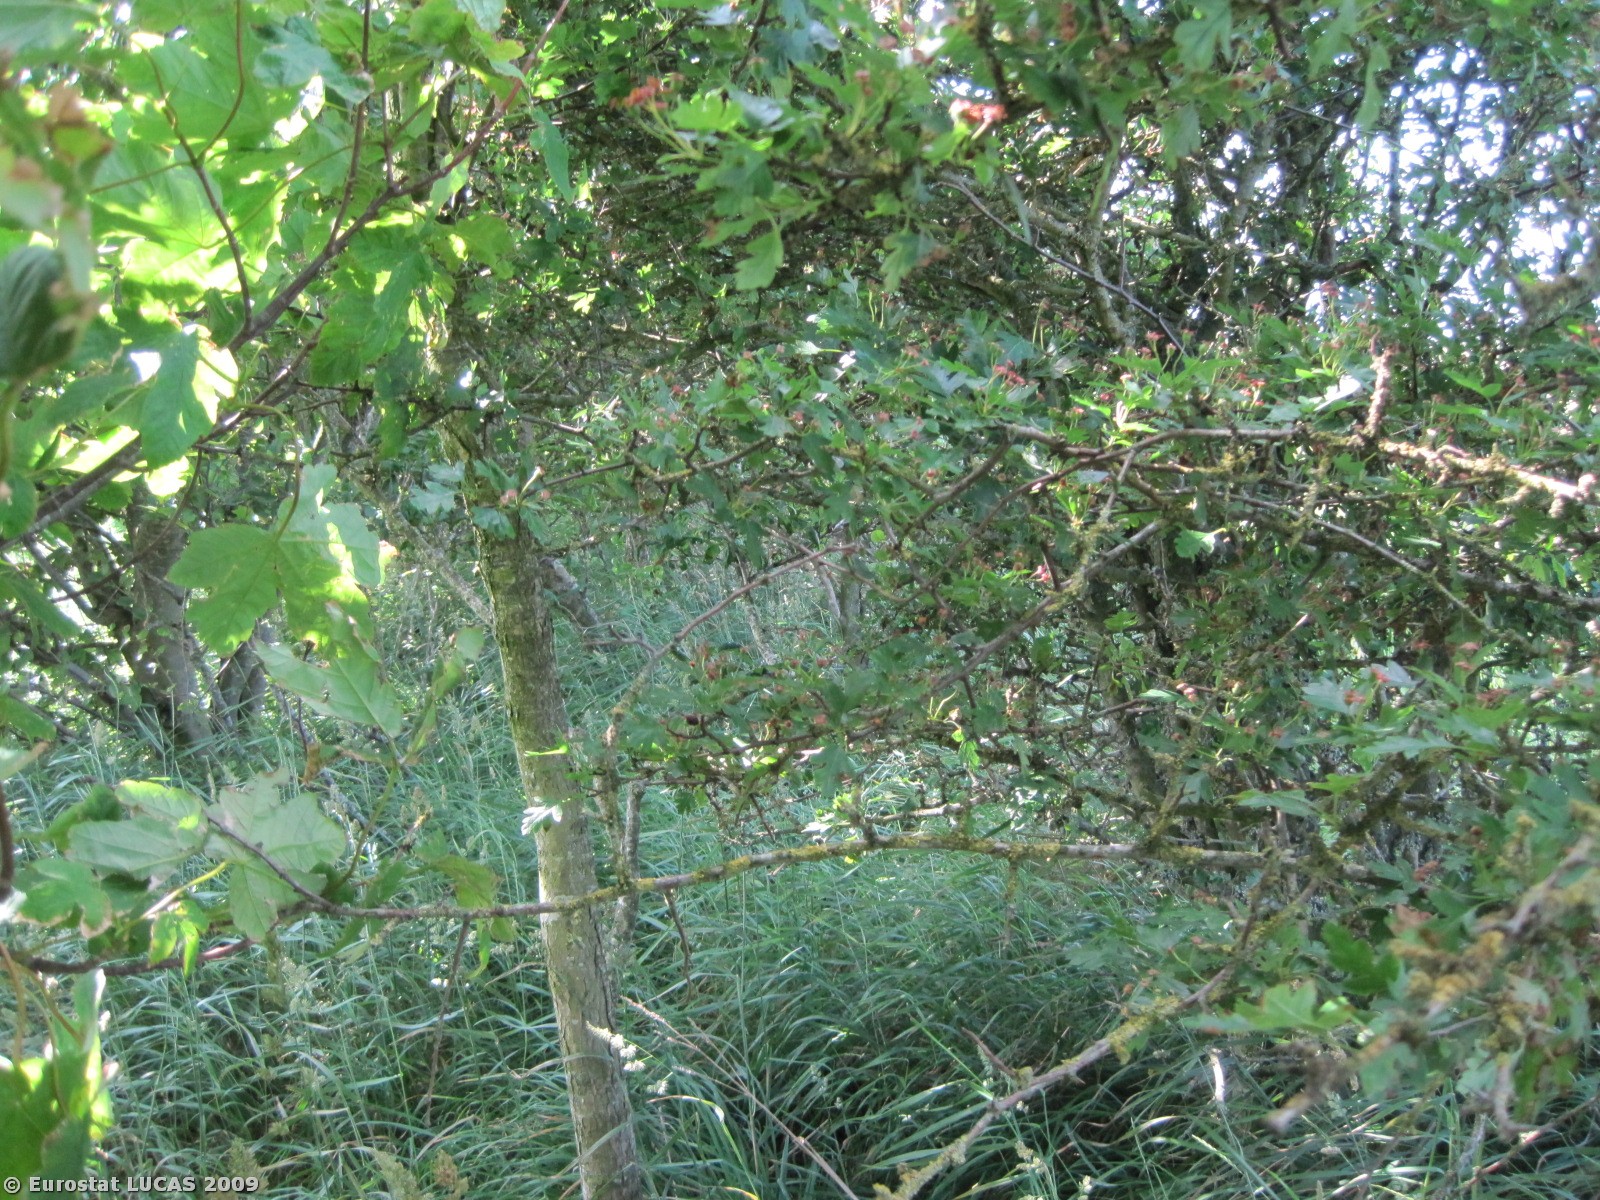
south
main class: Woodland
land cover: Broadleaved woodland
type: plantations and self-sown exotic forest
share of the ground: > 75 %
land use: Unused
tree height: > 5 m
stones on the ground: < 10 %
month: June
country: DK
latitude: 56.9043
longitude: 9.1966
